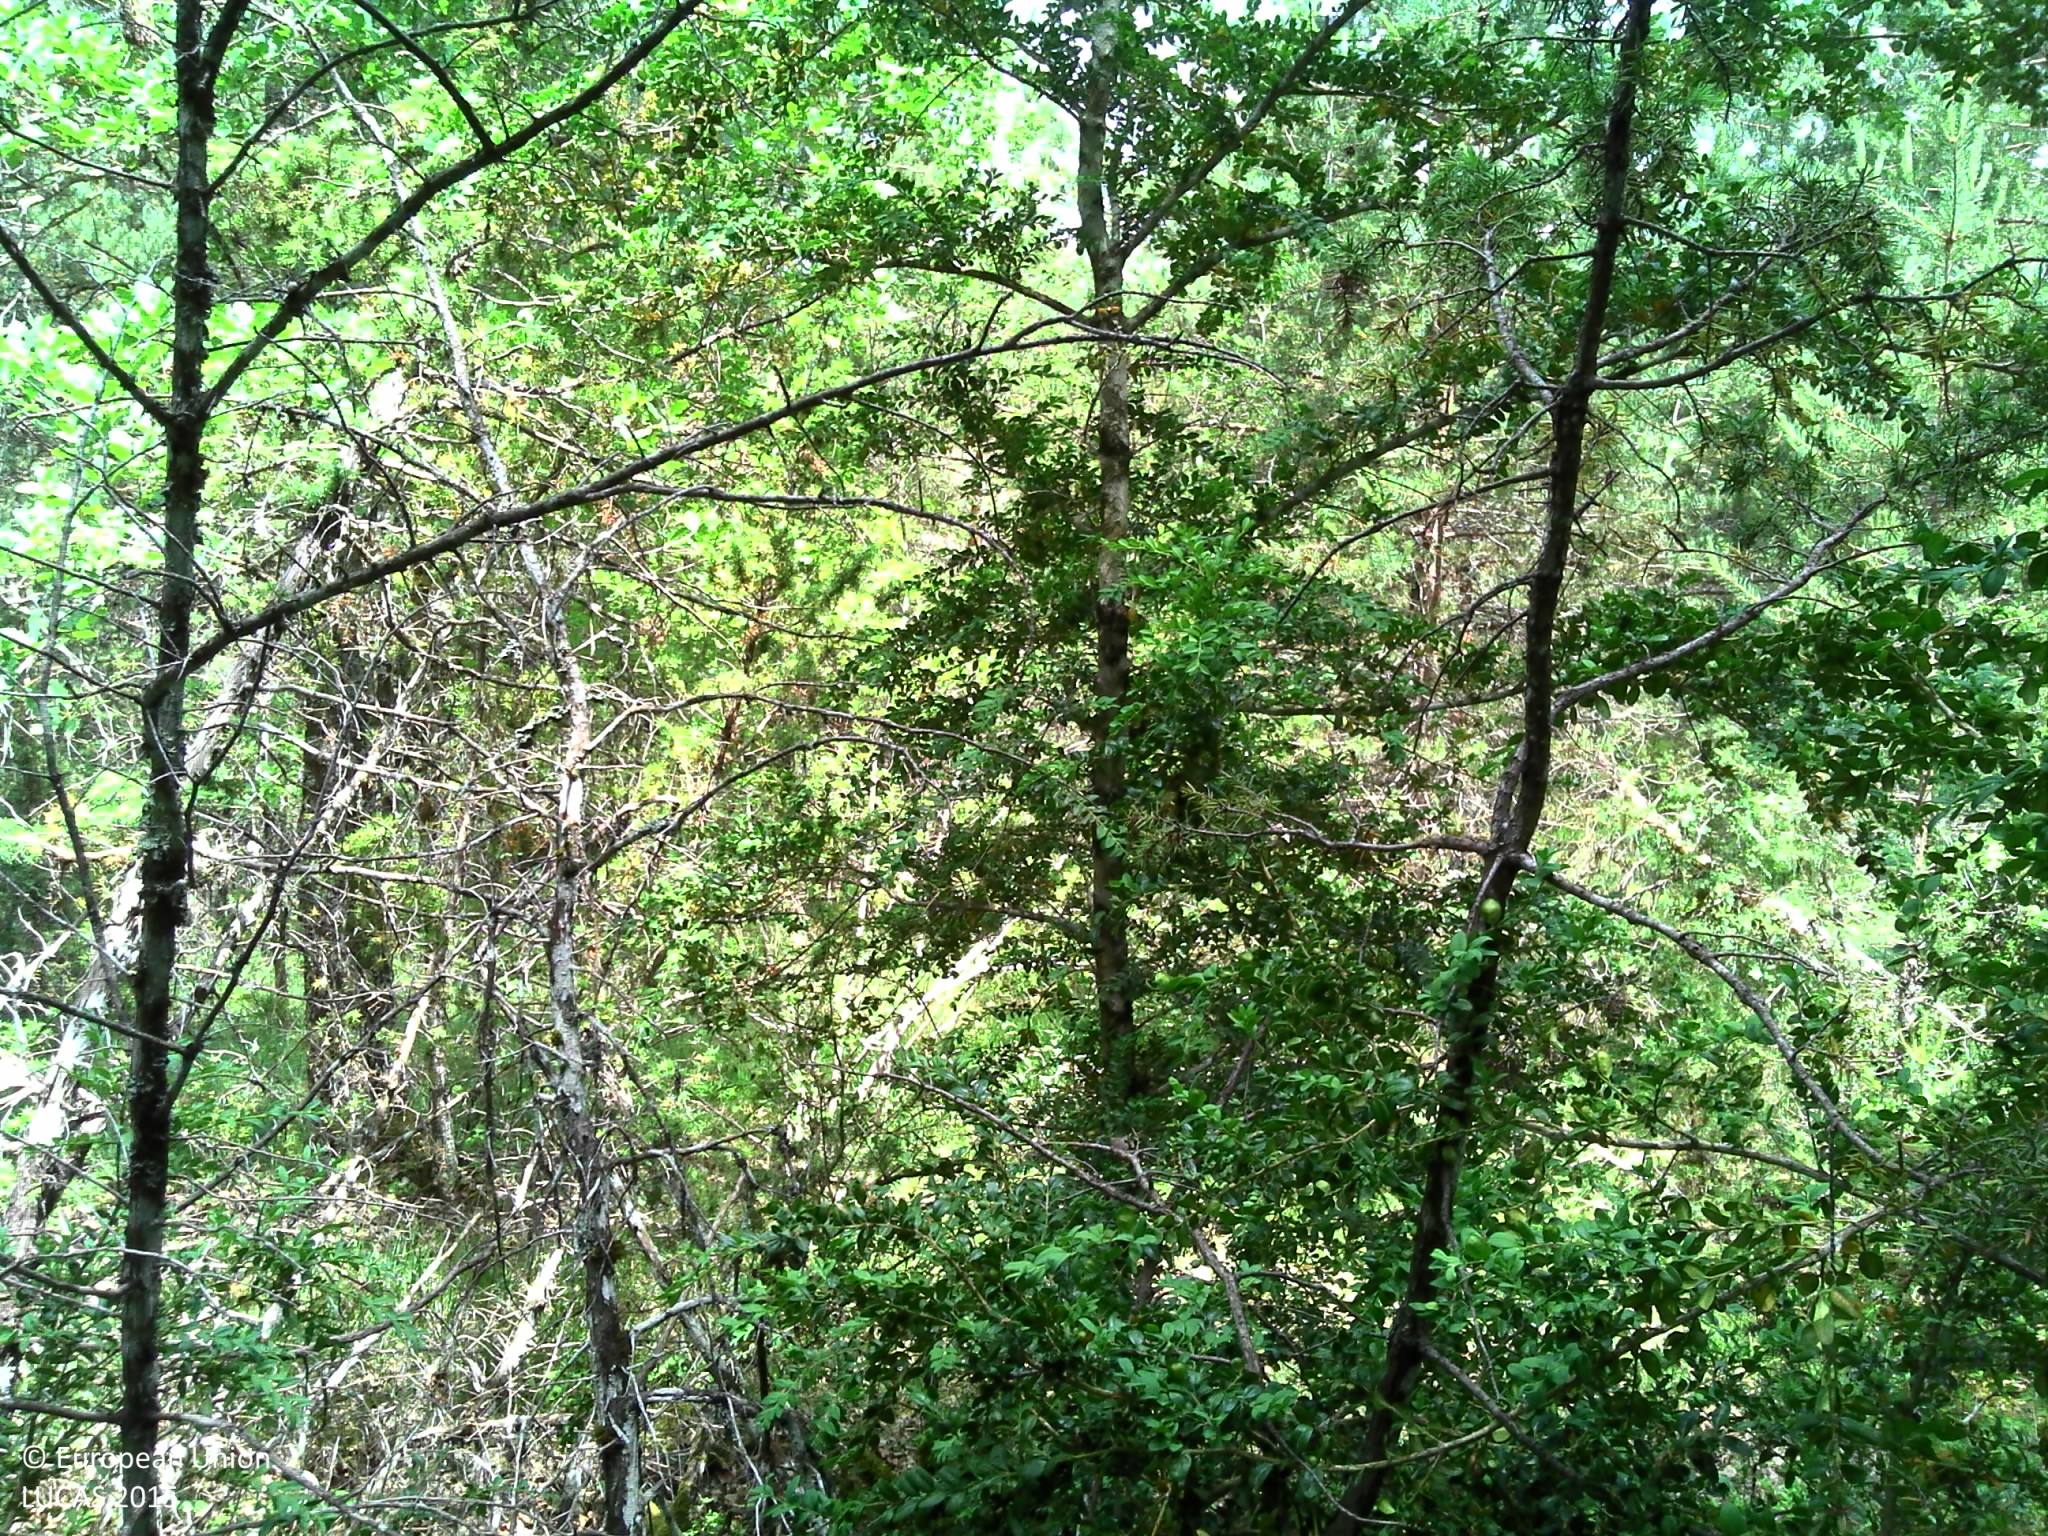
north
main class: Woodland
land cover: Pine dominated mixed woodland
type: mountainous beech forest
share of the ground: > 75 %
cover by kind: coniferous forest trees 35 %, broadleaved forest trees 35 %, herbaceous plants 20 %, lichens and mosses 10 %
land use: Forestry
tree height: > 5 m
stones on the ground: 25 - 50 %
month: June
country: FR
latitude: 44.1483
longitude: 3.2425
